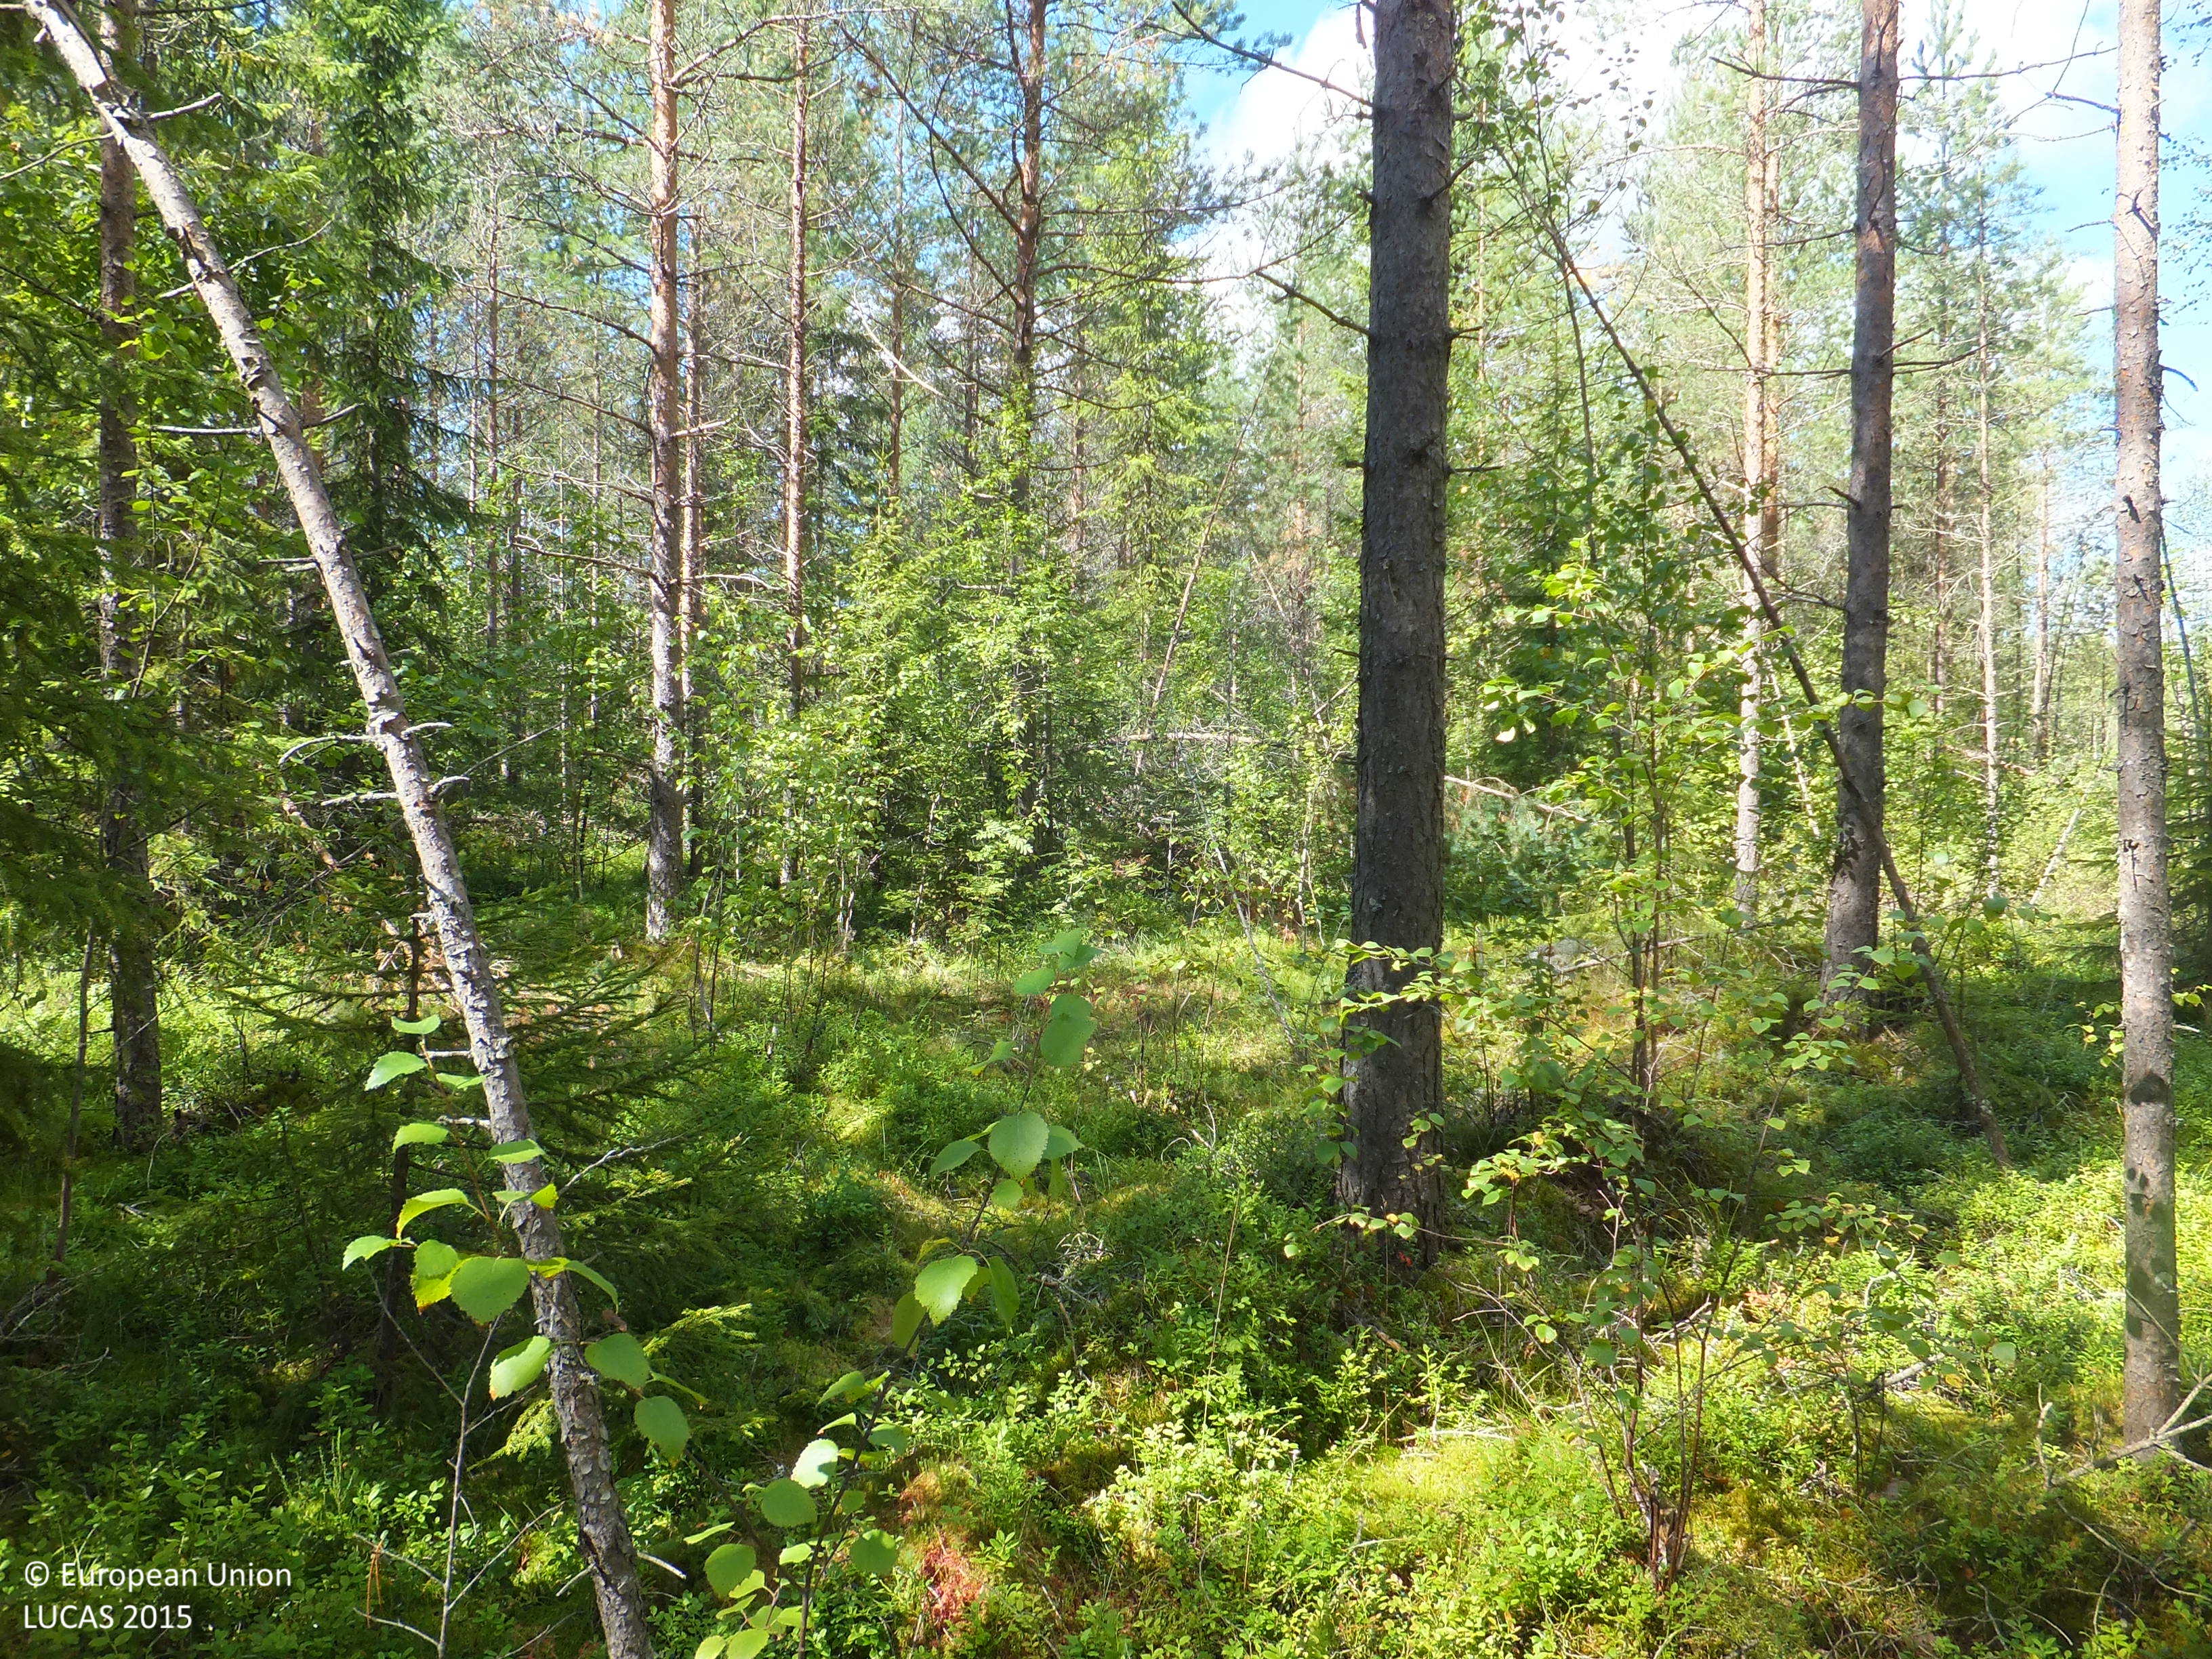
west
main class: Woodland
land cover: Pine dominated coniferous woodland
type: boreal forest
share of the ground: > 75 %
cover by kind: coniferous forest trees 75 %, shrubs 10 %, lichens and mosses 10 %, broadleaved forest trees 5 %
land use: Forestry
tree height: > 5 m
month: August
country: FI
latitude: 63.2645
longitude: 23.1082
